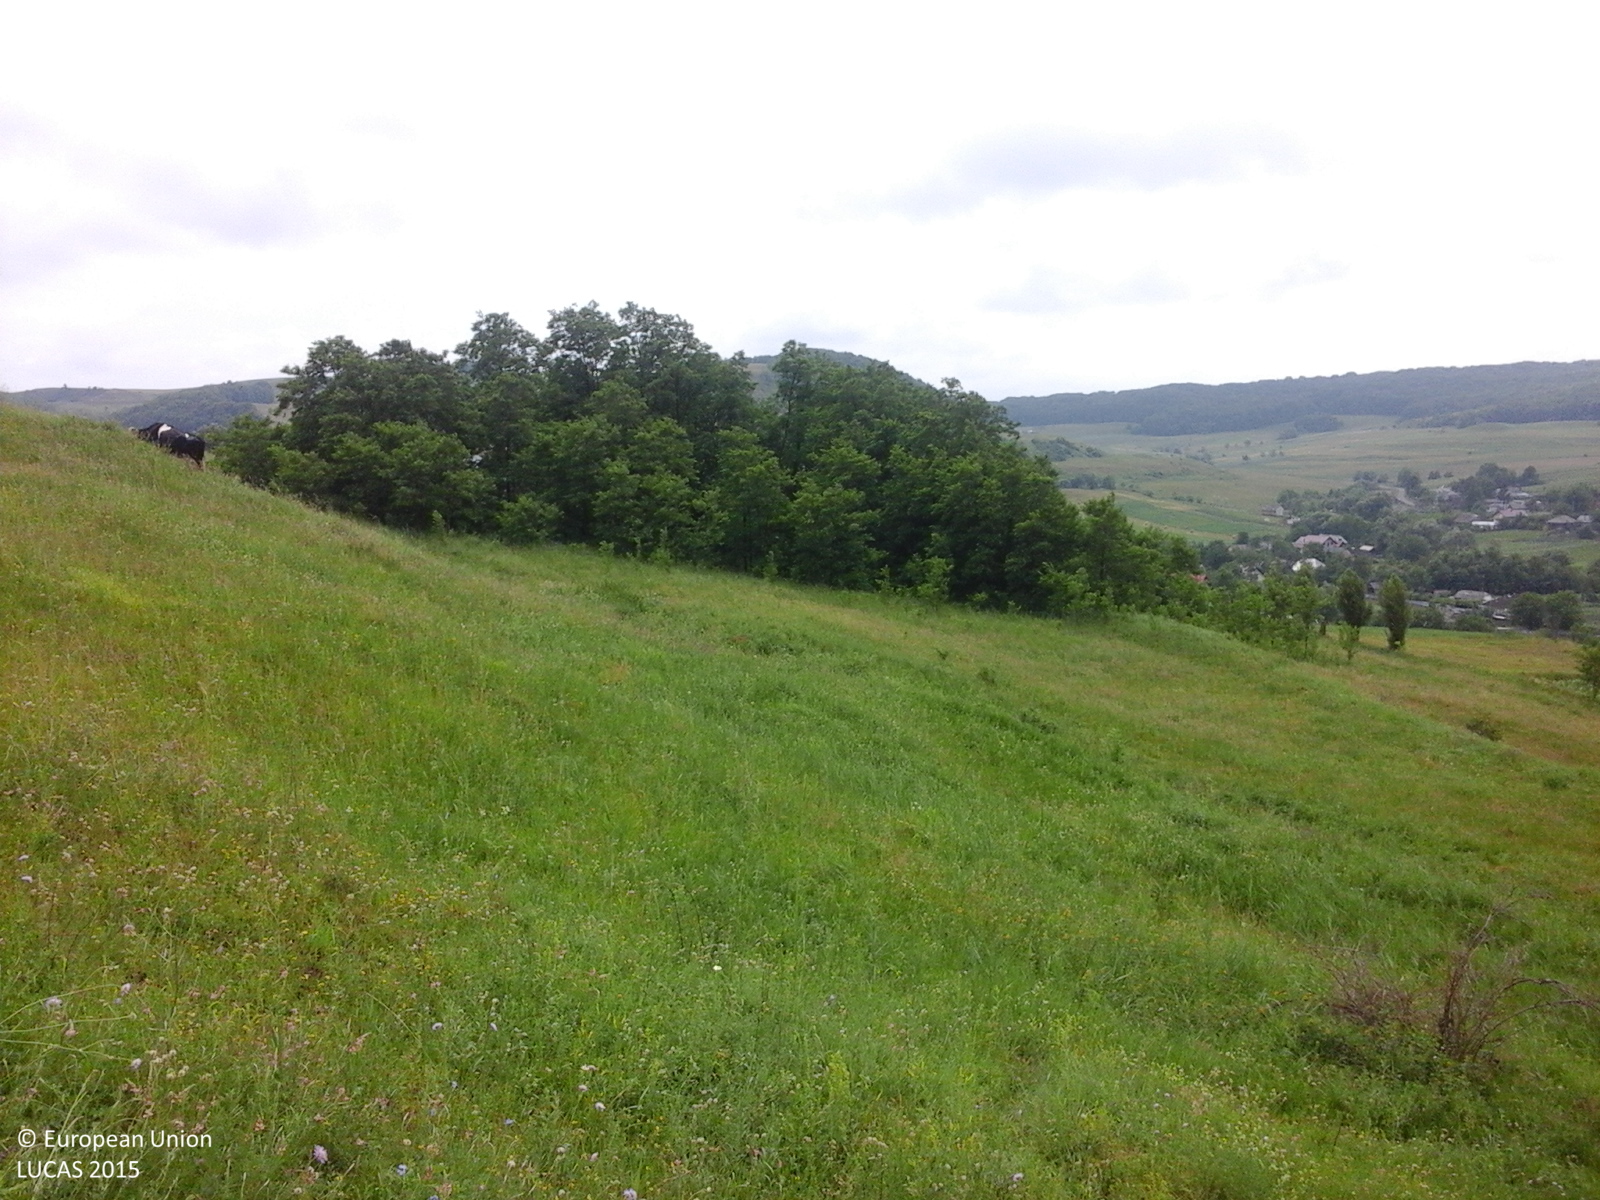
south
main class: Grassland
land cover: Grassland without tree/shrub cover
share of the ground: > 75 %
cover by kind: herbaceous plants 100 %
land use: Agriculture (excluding fallow land and kitchen gardens)
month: June
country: RO
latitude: 47.4281
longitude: 26.3782
